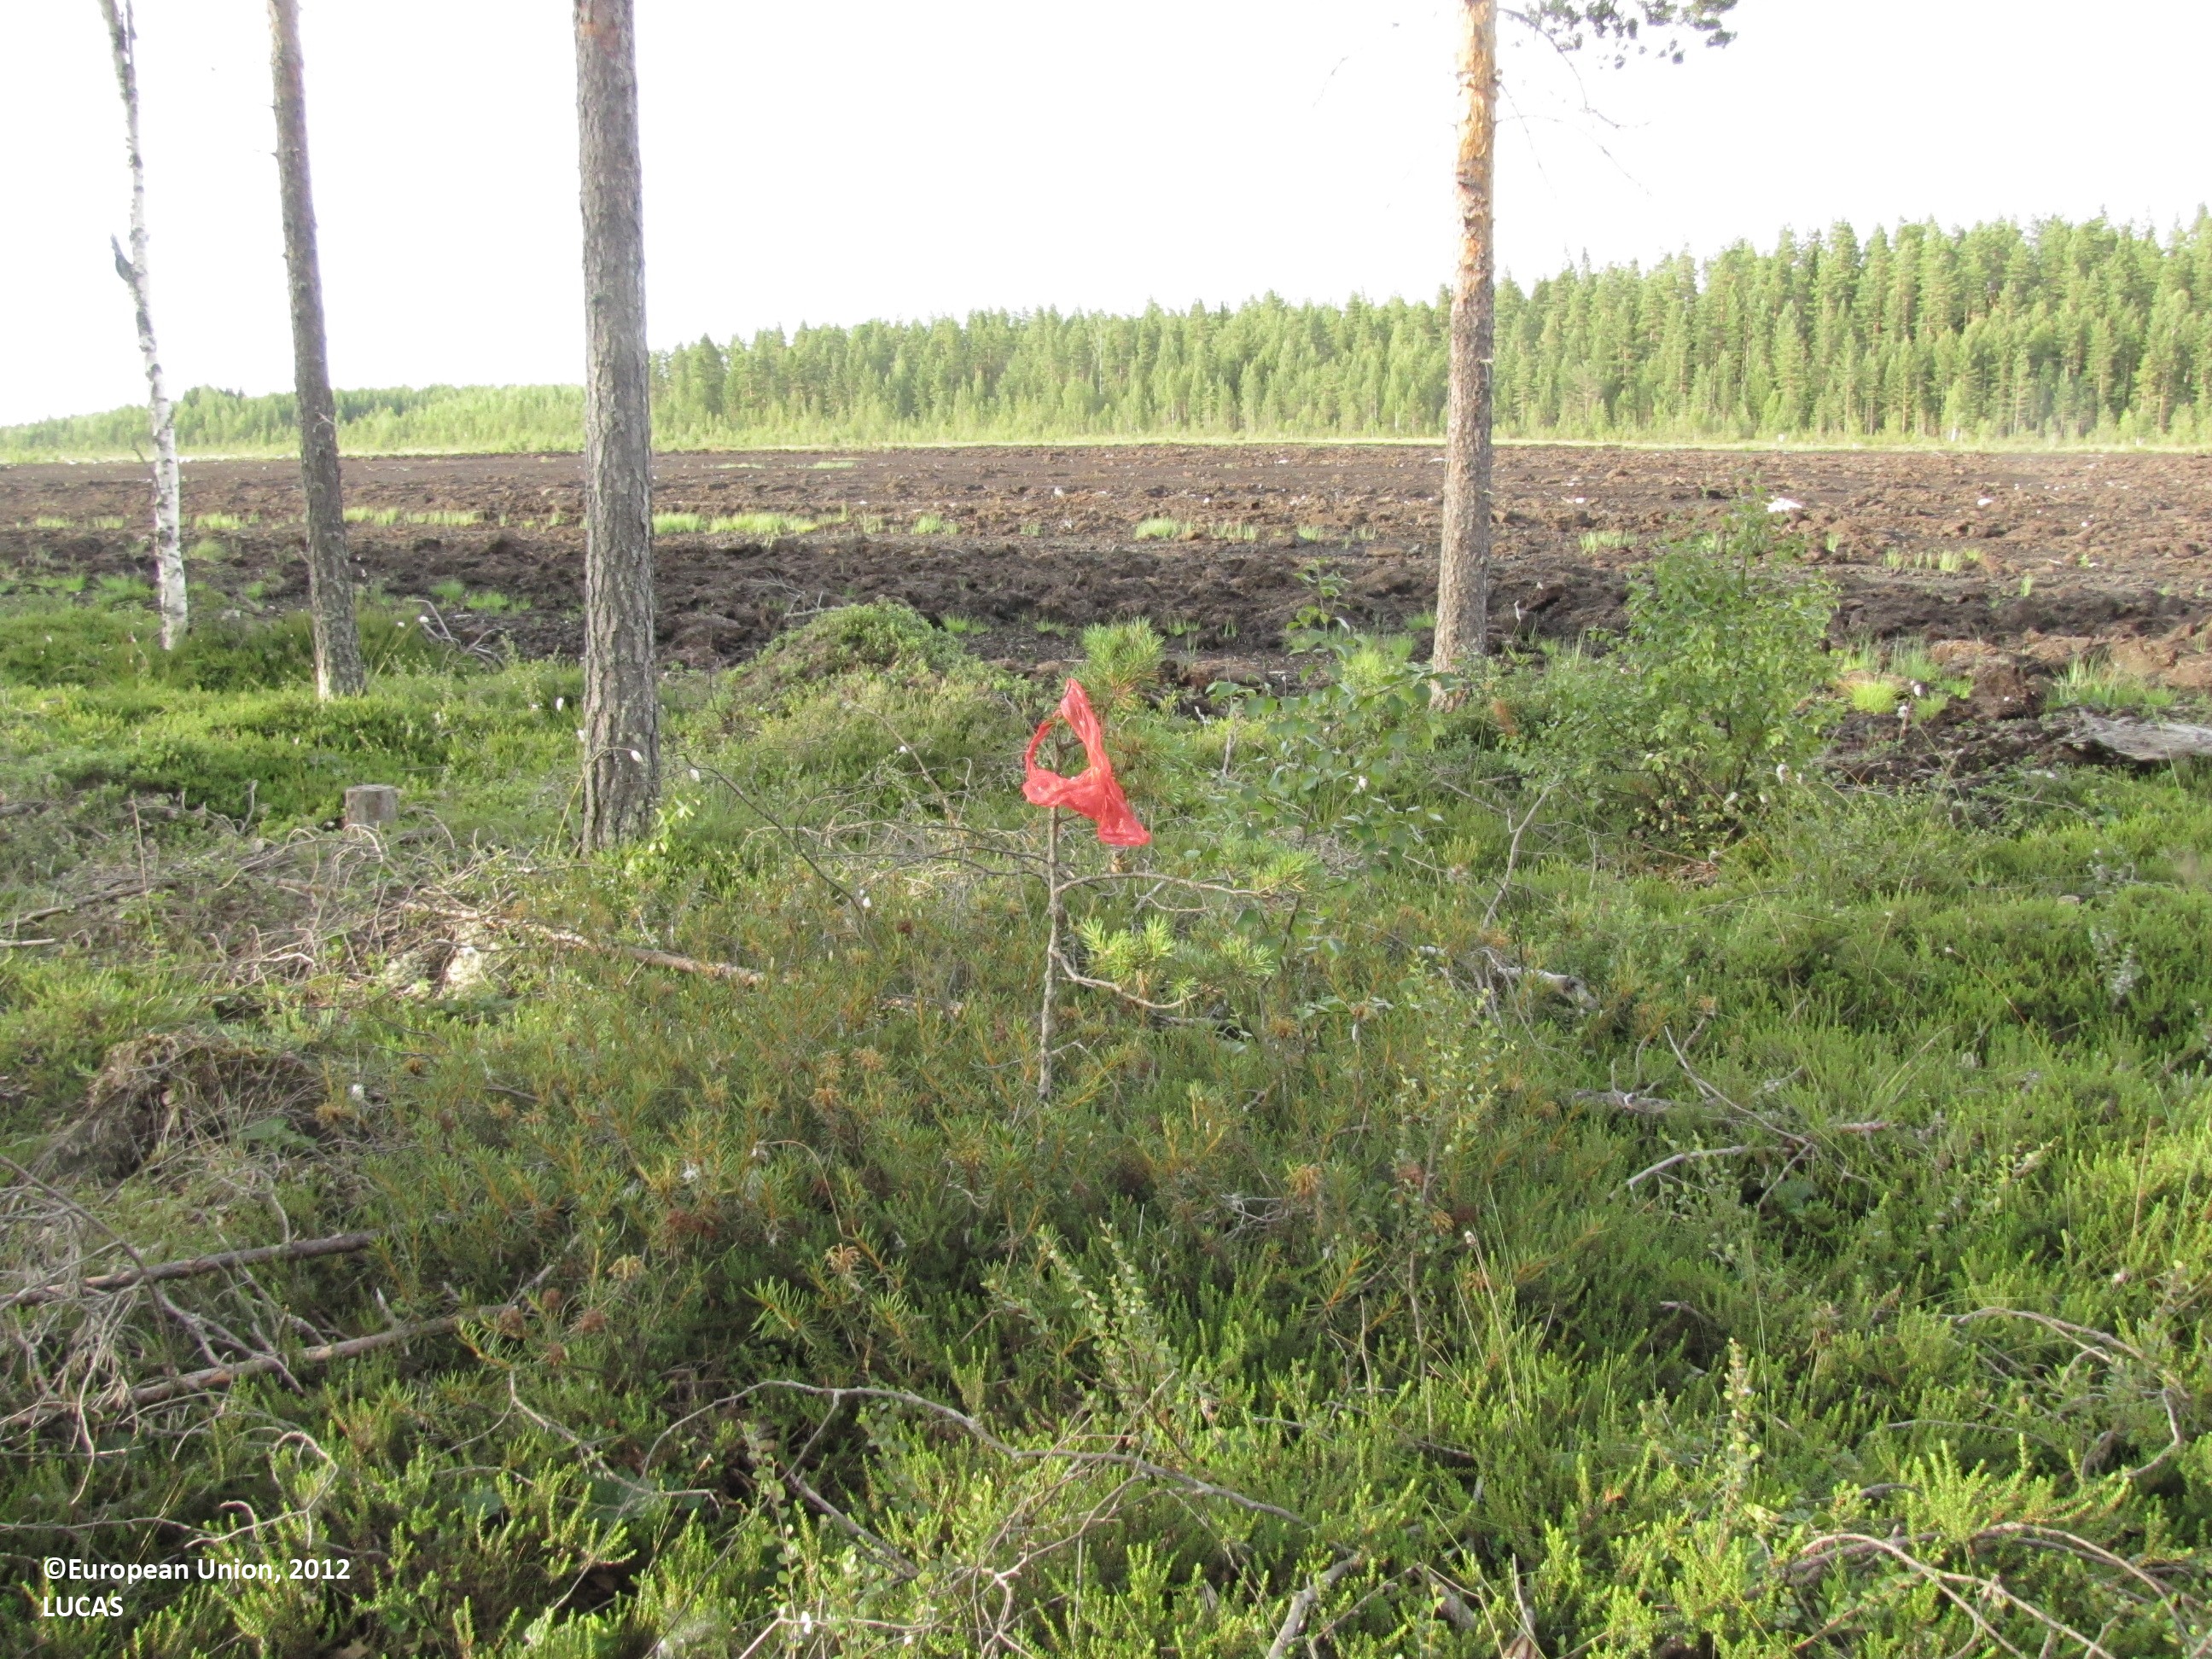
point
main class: Woodland
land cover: Pine dominated coniferous woodland
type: mire and swamp forests
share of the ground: 50 - 75 %
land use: Forestry
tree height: > 5 m
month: July
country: FI
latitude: 62.4906
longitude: 23.5597
